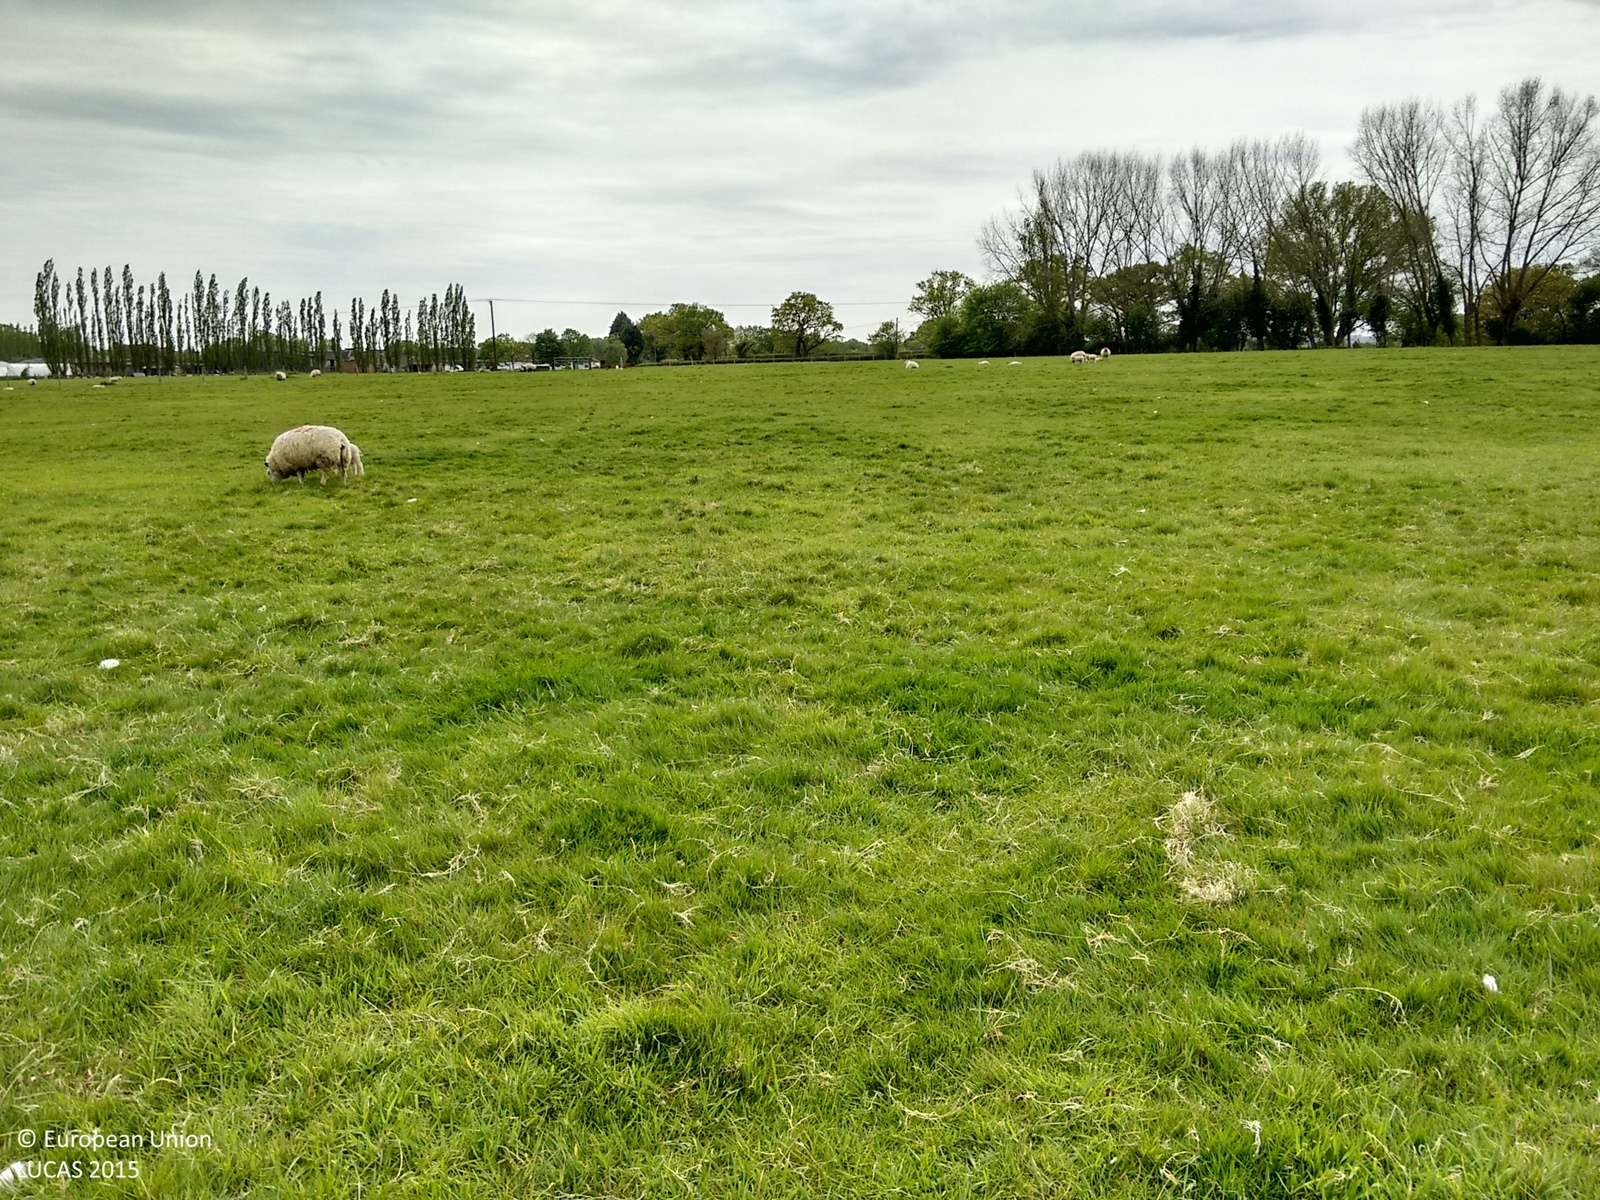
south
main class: Grassland
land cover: Grassland without tree/shrub cover
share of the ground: > 75 %
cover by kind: herbaceous plants 100 %
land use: Agriculture (excluding fallow land and kitchen gardens)
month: May
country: GB
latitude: 51.2047
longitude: 0.5692
